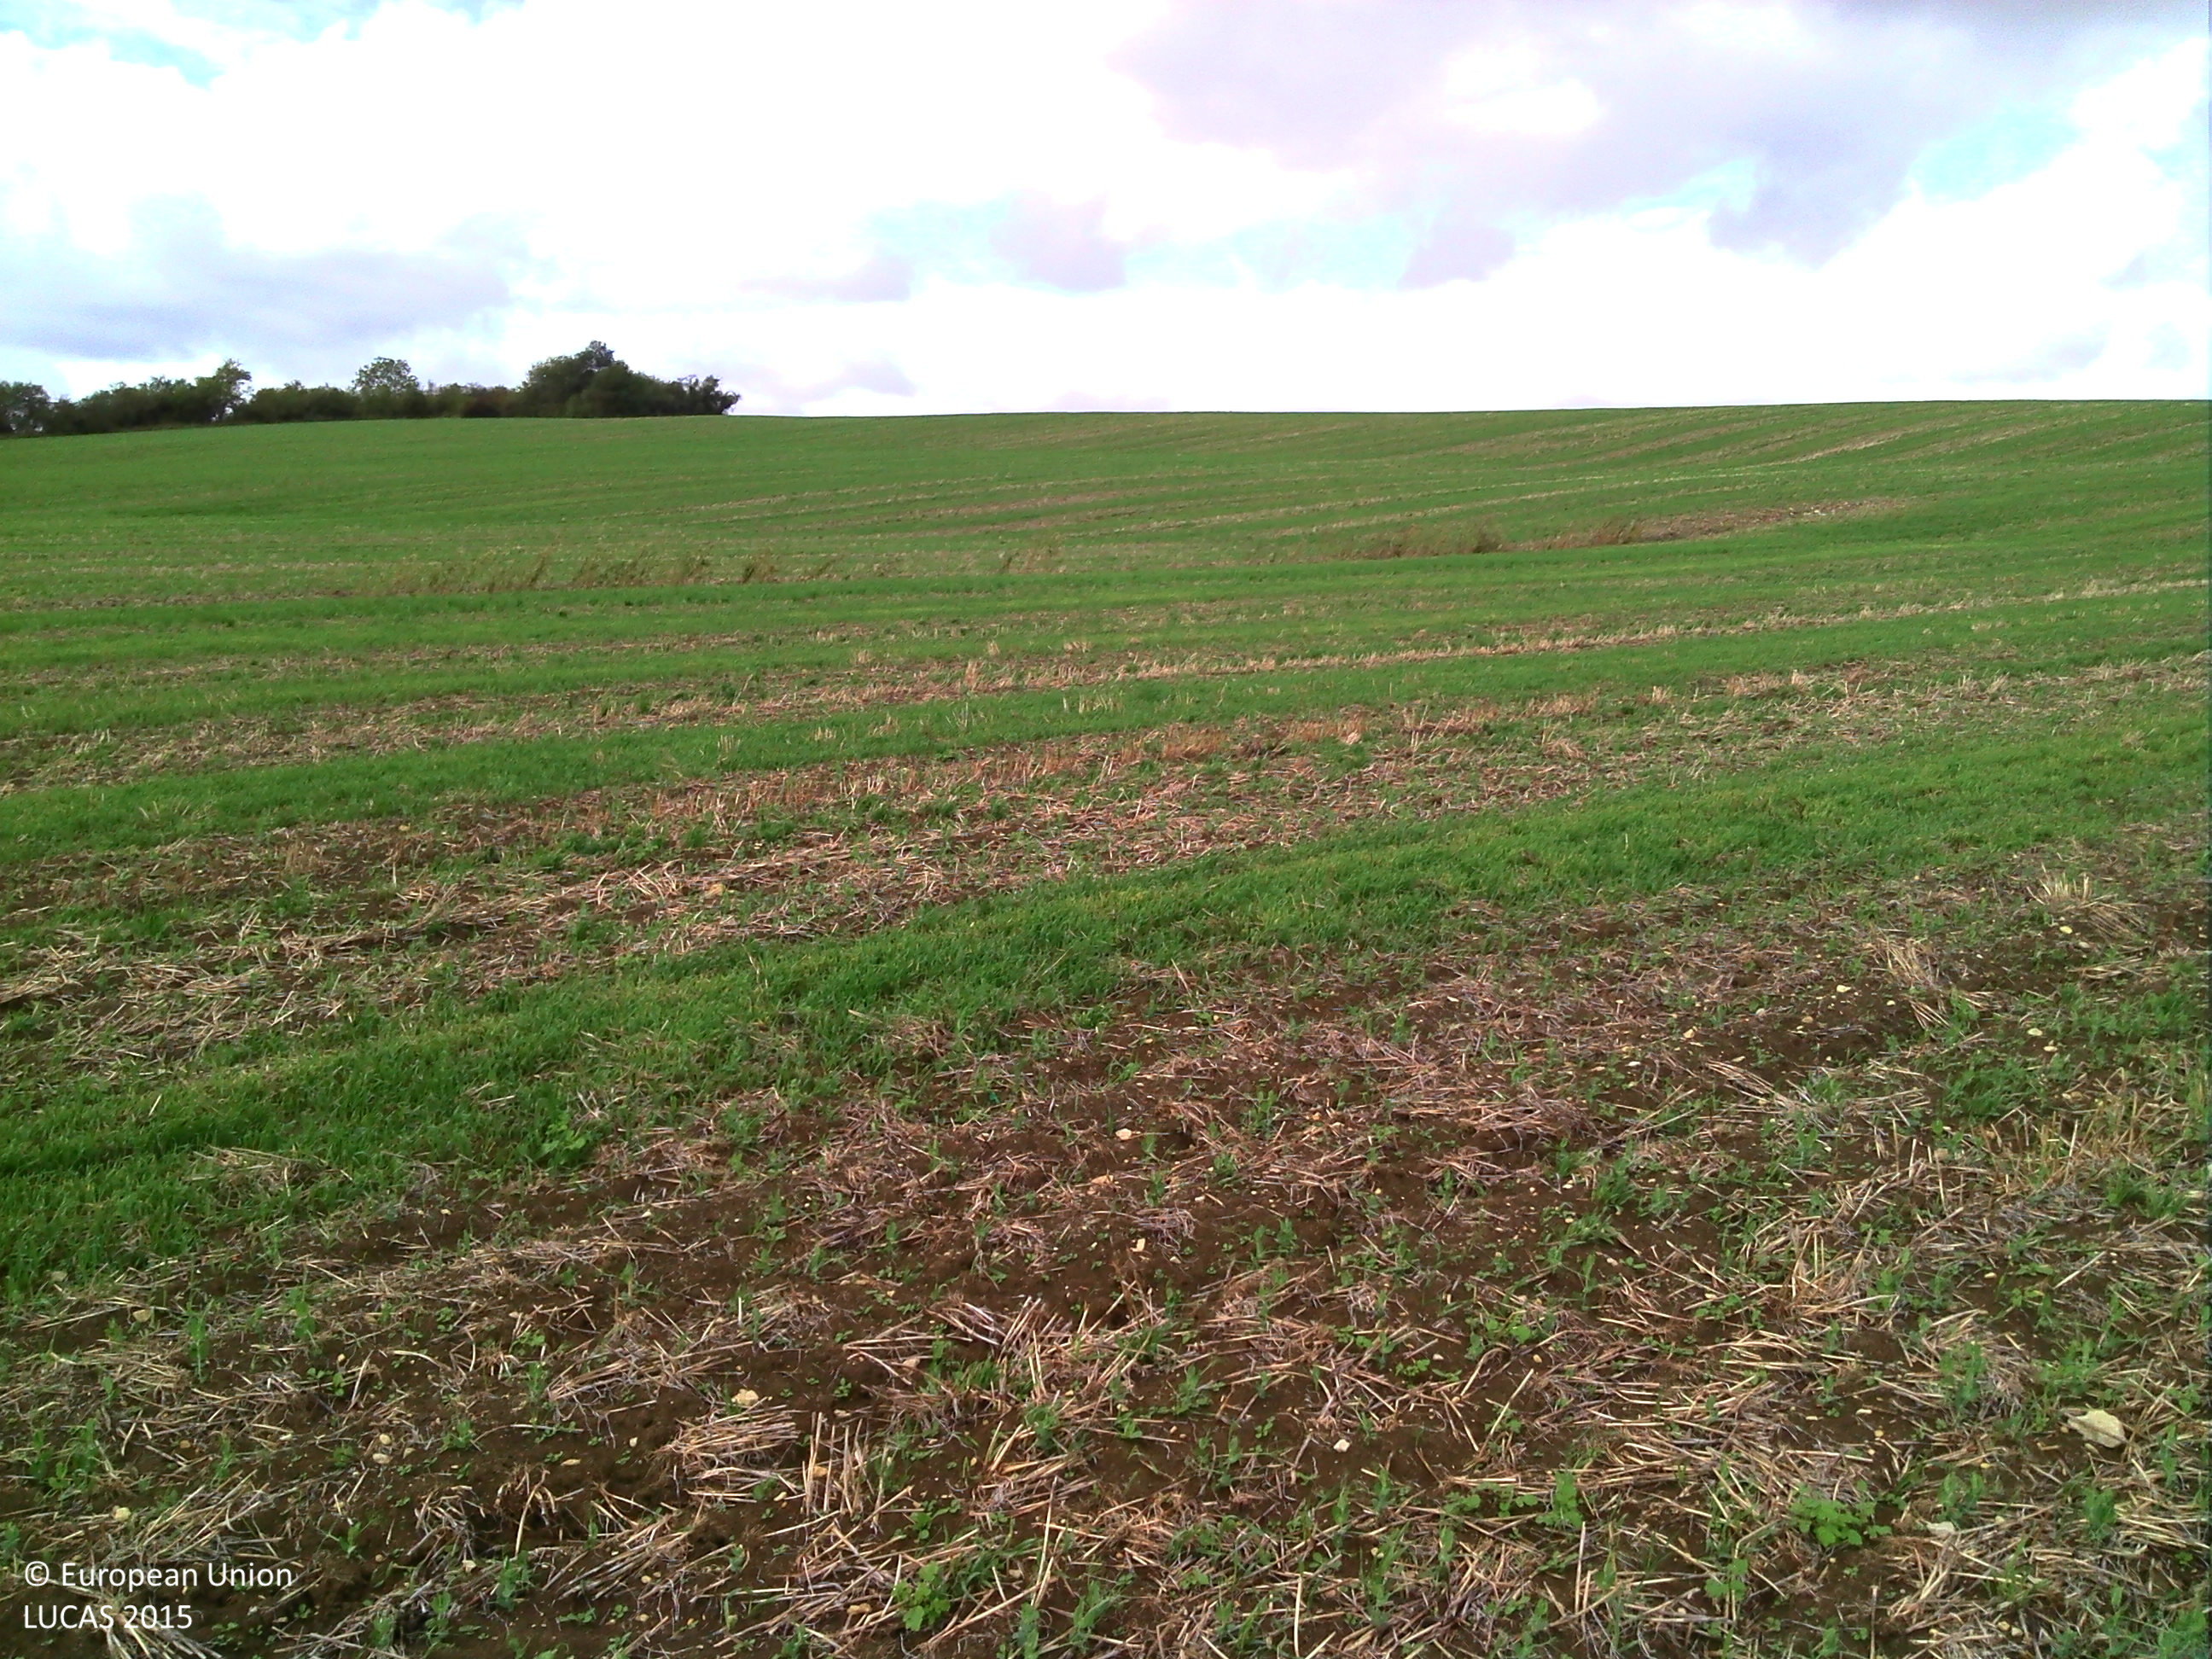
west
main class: Cropland
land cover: Other fibre and oleaginous crops
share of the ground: > 75 %
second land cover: Other leguminous and mixtures for fodder
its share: 10 - 25 %
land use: Agriculture (excluding fallow land and kitchen gardens)
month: September
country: FR
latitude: 48.2420
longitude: 4.7332
